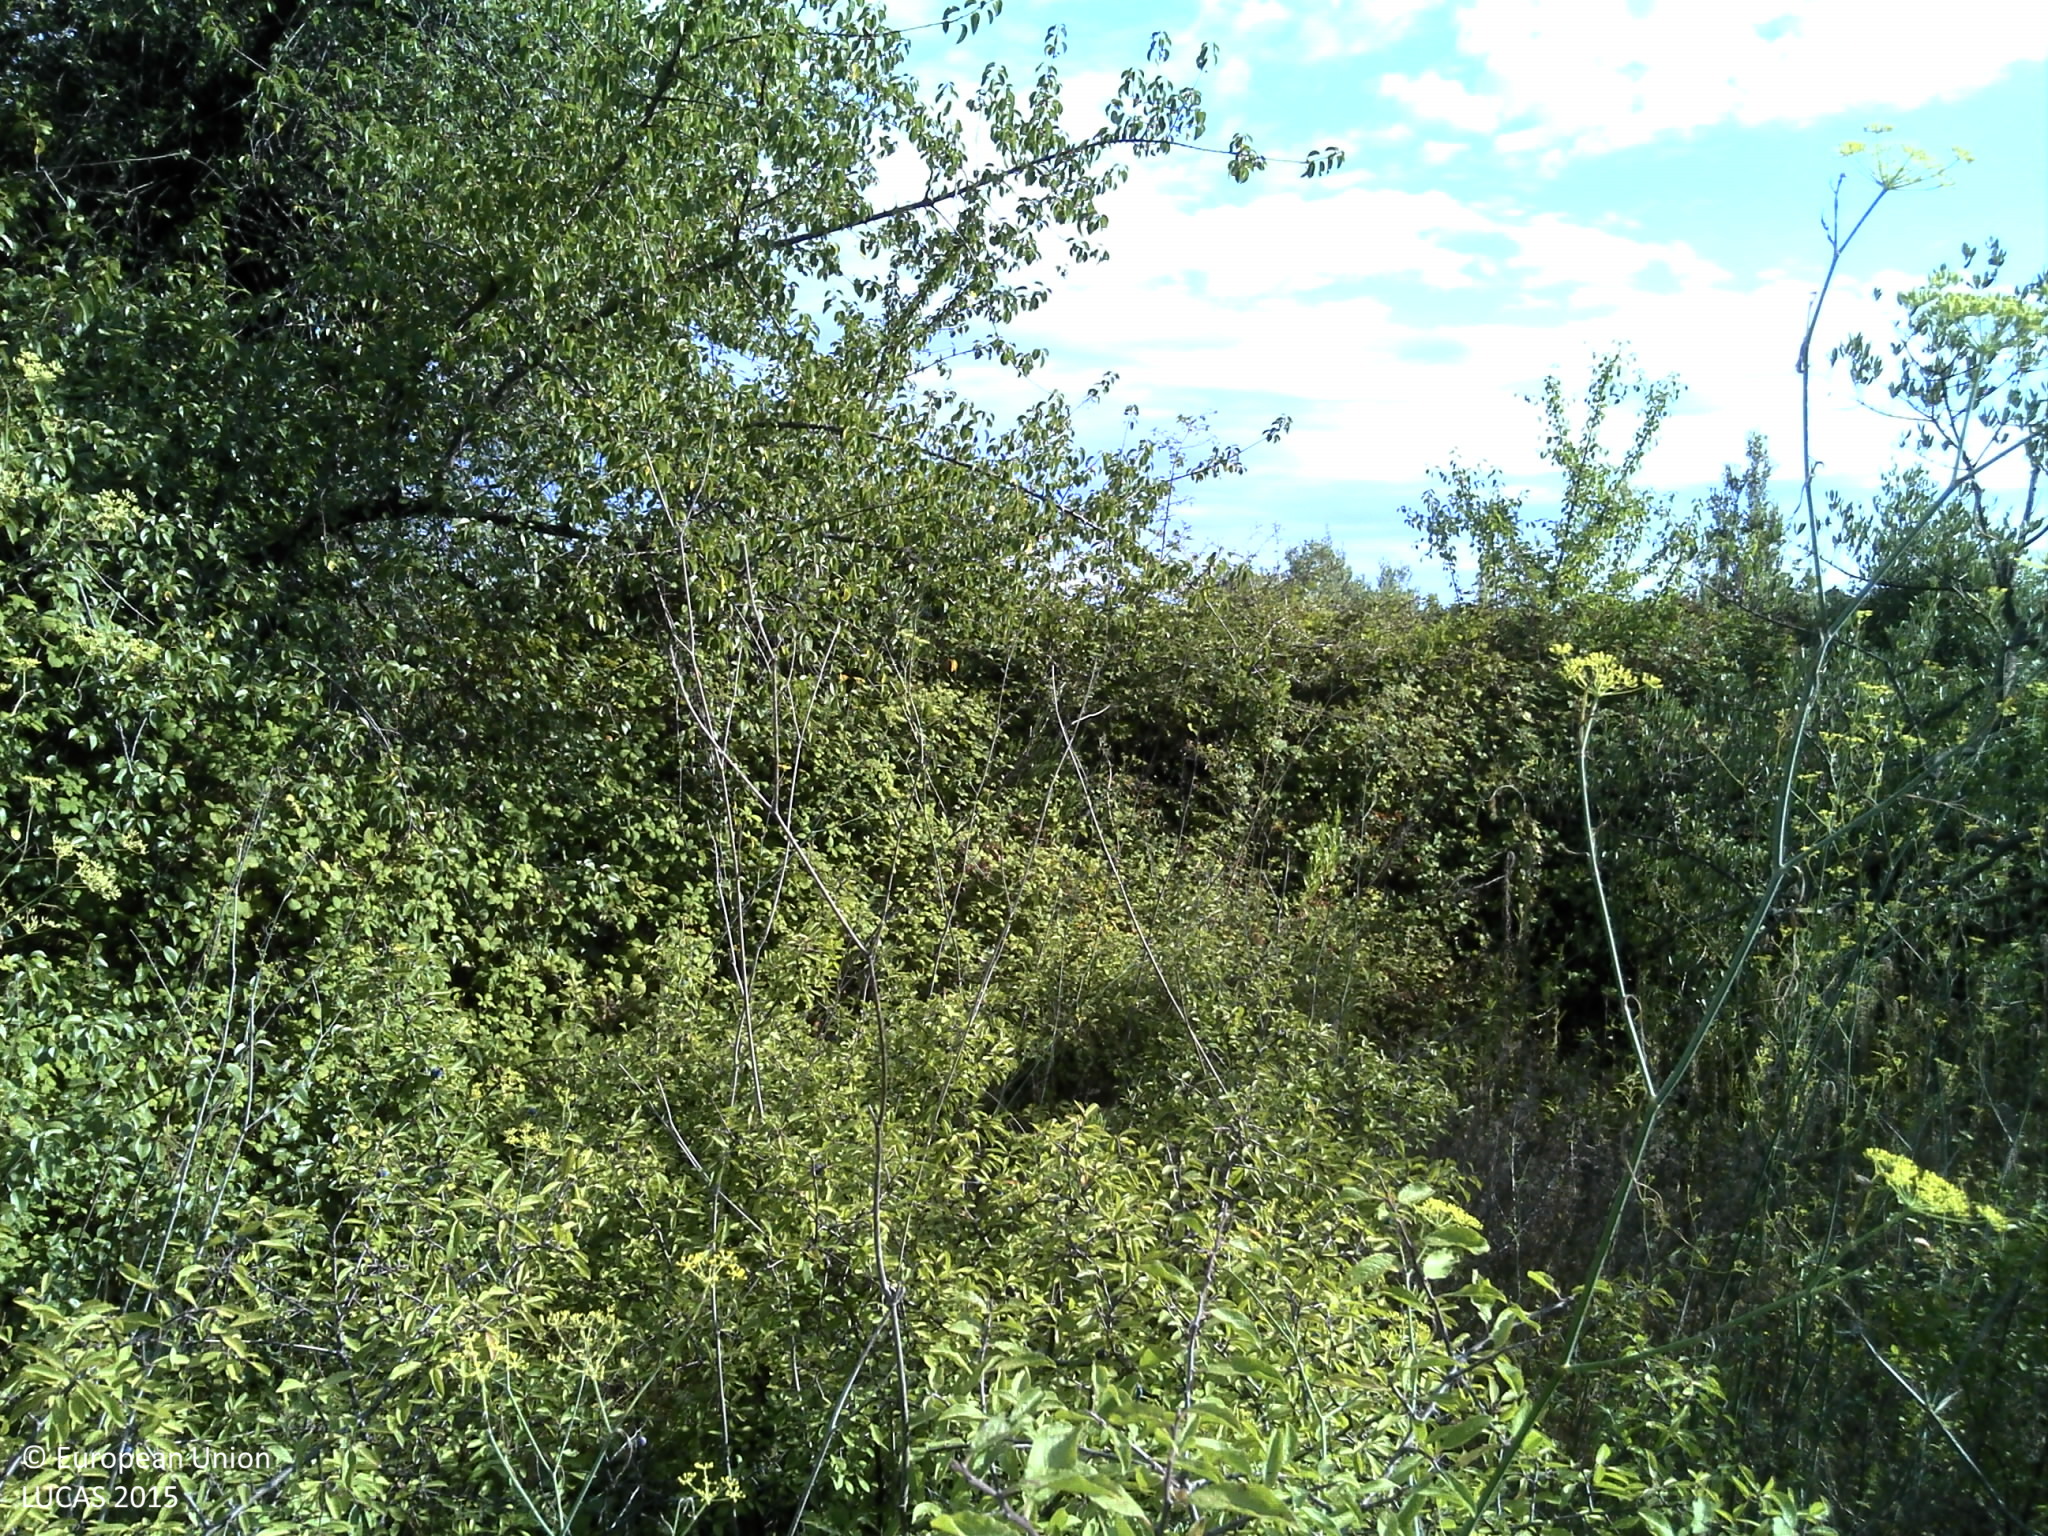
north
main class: Shrubland
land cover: Shrubland with sparse tree cover
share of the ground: > 75 %
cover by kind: shrubs 70 %, herbaceous plants 15 %, broadleaved forest trees 5 %, consolidated bare surface 5 %, unconsolidated bare surface 5 %
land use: Semi-natural and natural areas not in use
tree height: < 5 m
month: August
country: HR
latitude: 43.3603
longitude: 16.3447
